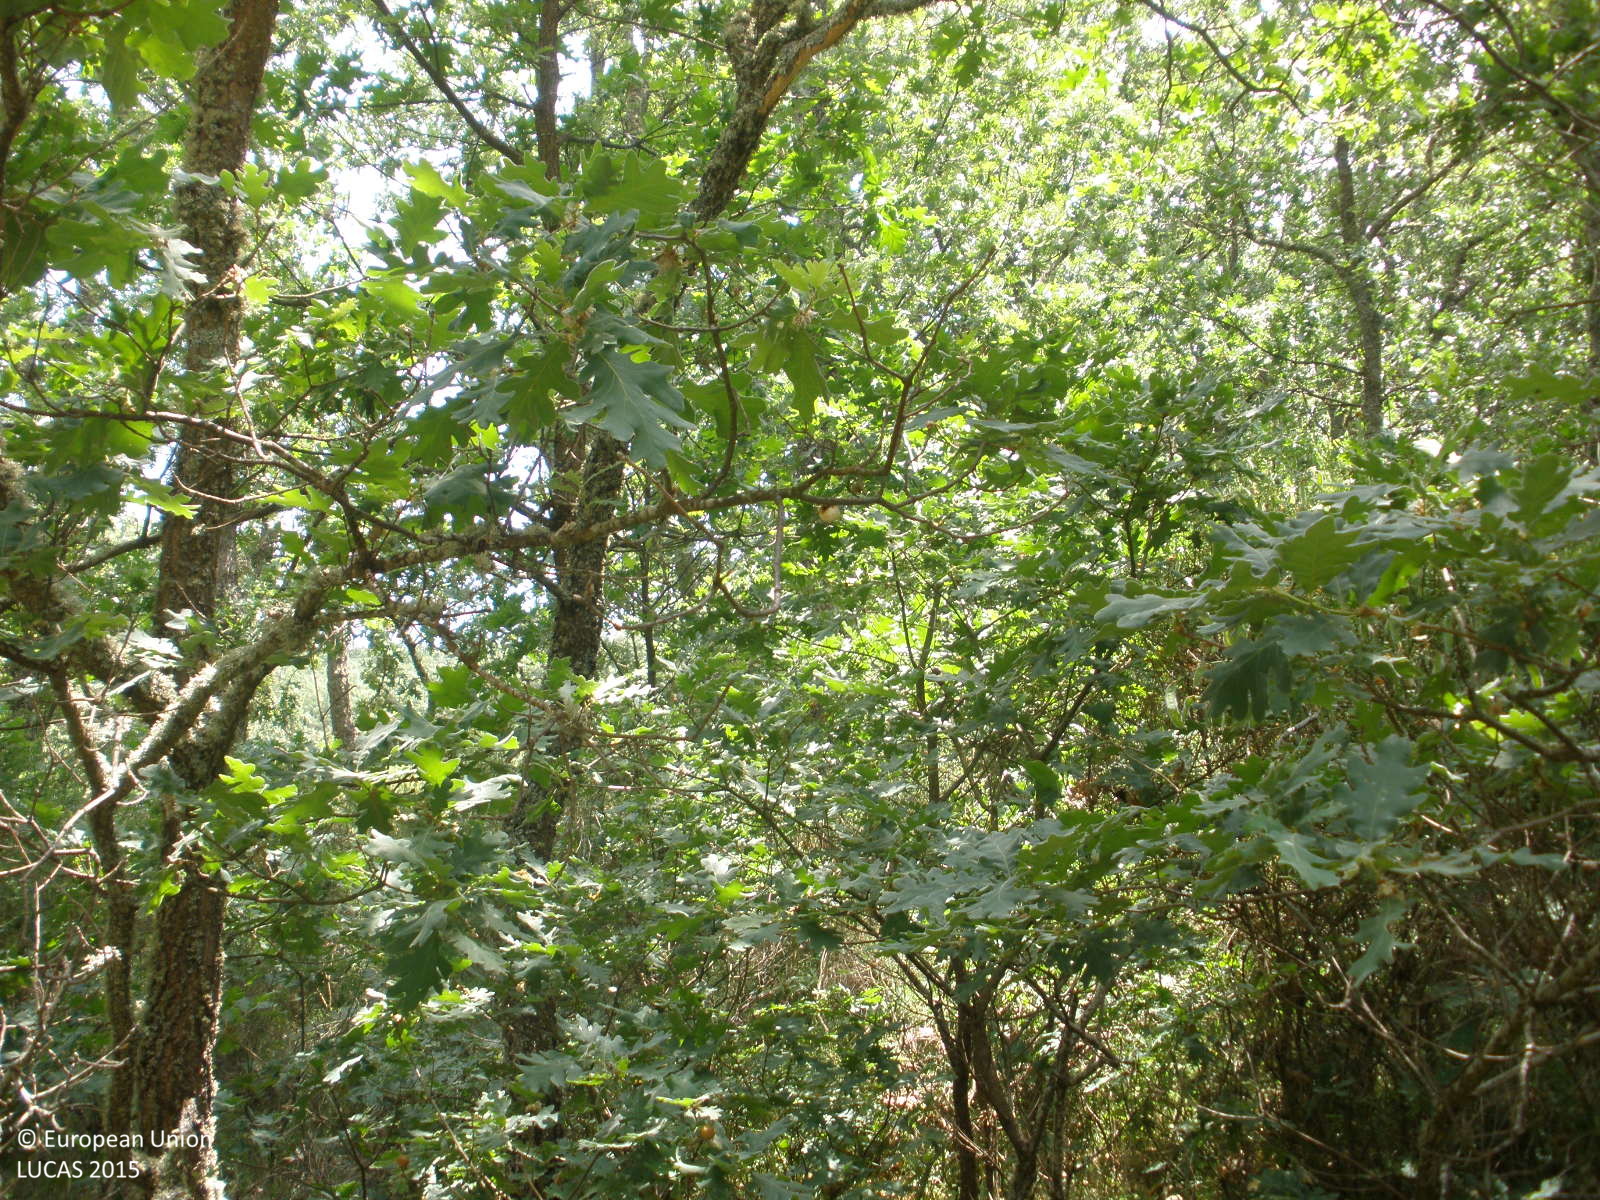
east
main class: Woodland
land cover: Broadleaved woodland
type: thermophilous deciduous forest
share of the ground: > 75 %
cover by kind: broadleaved forest trees 70 %, herbaceous plants 30 %
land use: Agriculture (excluding fallow land and kitchen gardens)
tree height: > 5 m
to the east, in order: Broadleaved woodland; Tracks; Broadleaved woodland; Rivers and streams; Broadleaved woodland
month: June
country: ES
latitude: 40.5566
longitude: -6.1540
